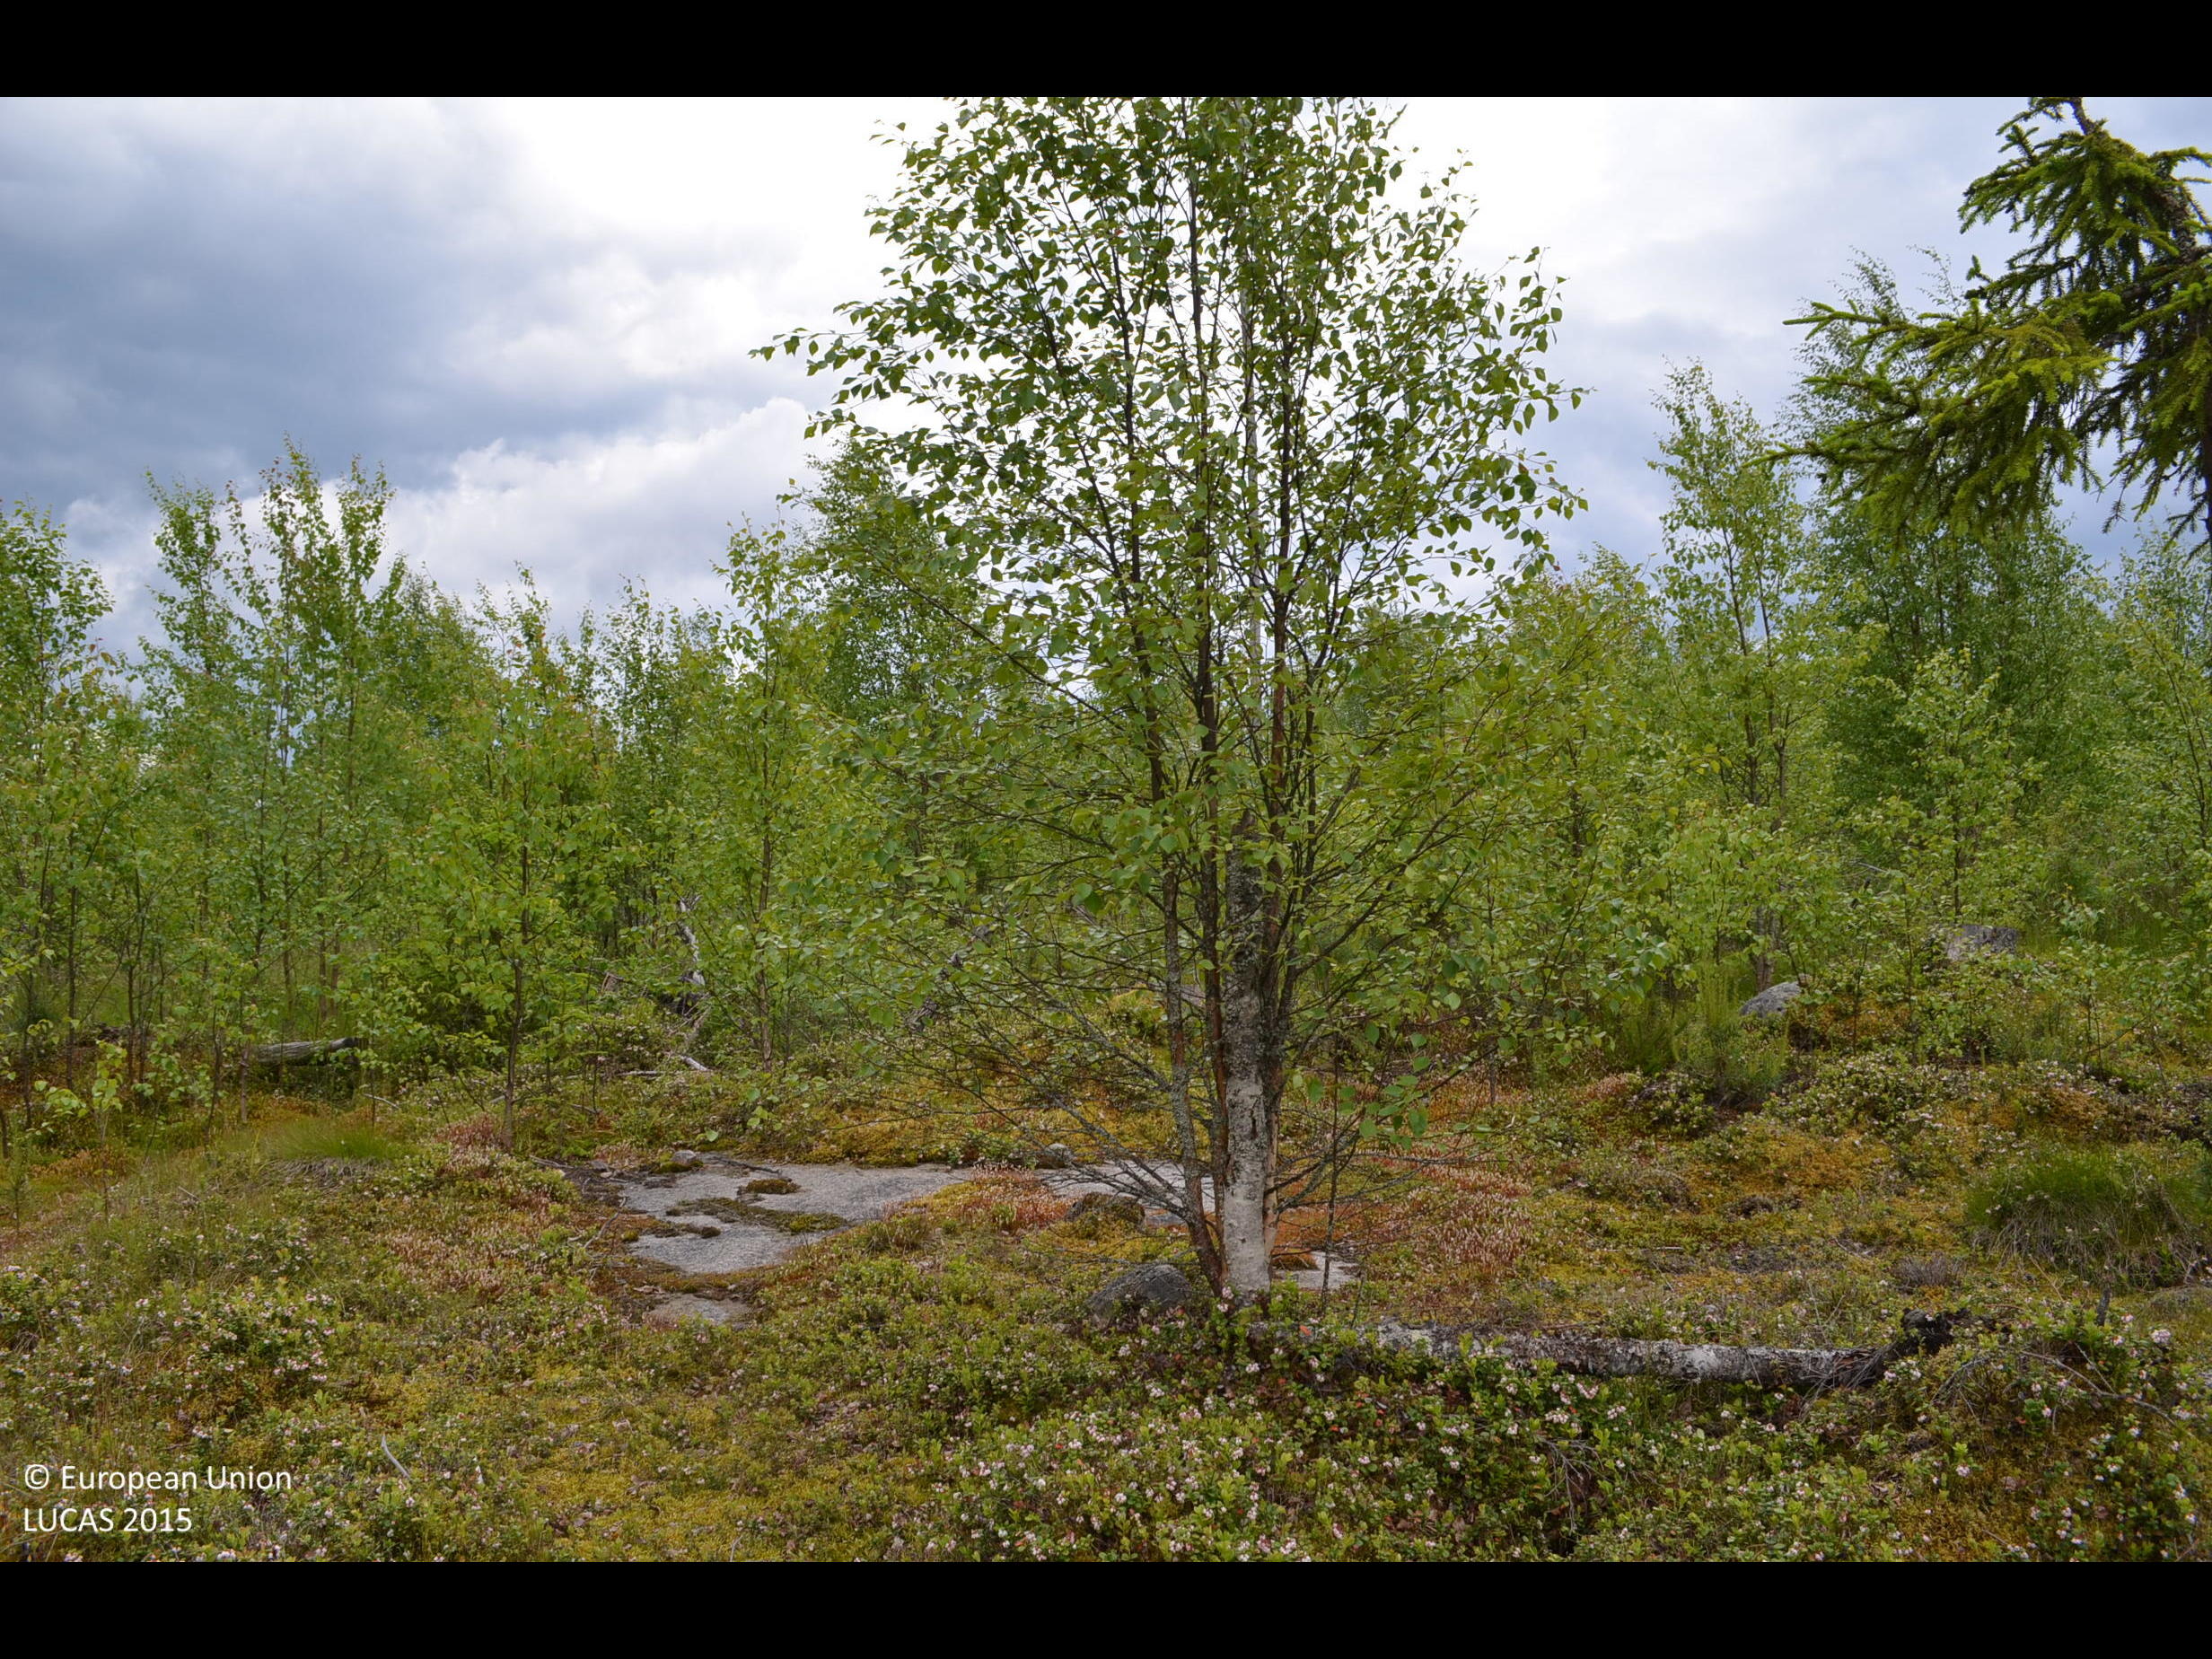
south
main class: Woodland
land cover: Other mixed woodland
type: boreal forest
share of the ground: 25 - 50 %
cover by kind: broadleaved forest trees 30 %, shrubs 30 %, herbaceous plants 20 %, coniferous forest trees 15 %, lichens and mosses 5 %
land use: Forestry
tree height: < 5 m
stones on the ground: < 10 %
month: June
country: FI
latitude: 62.0993
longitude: 23.4251
